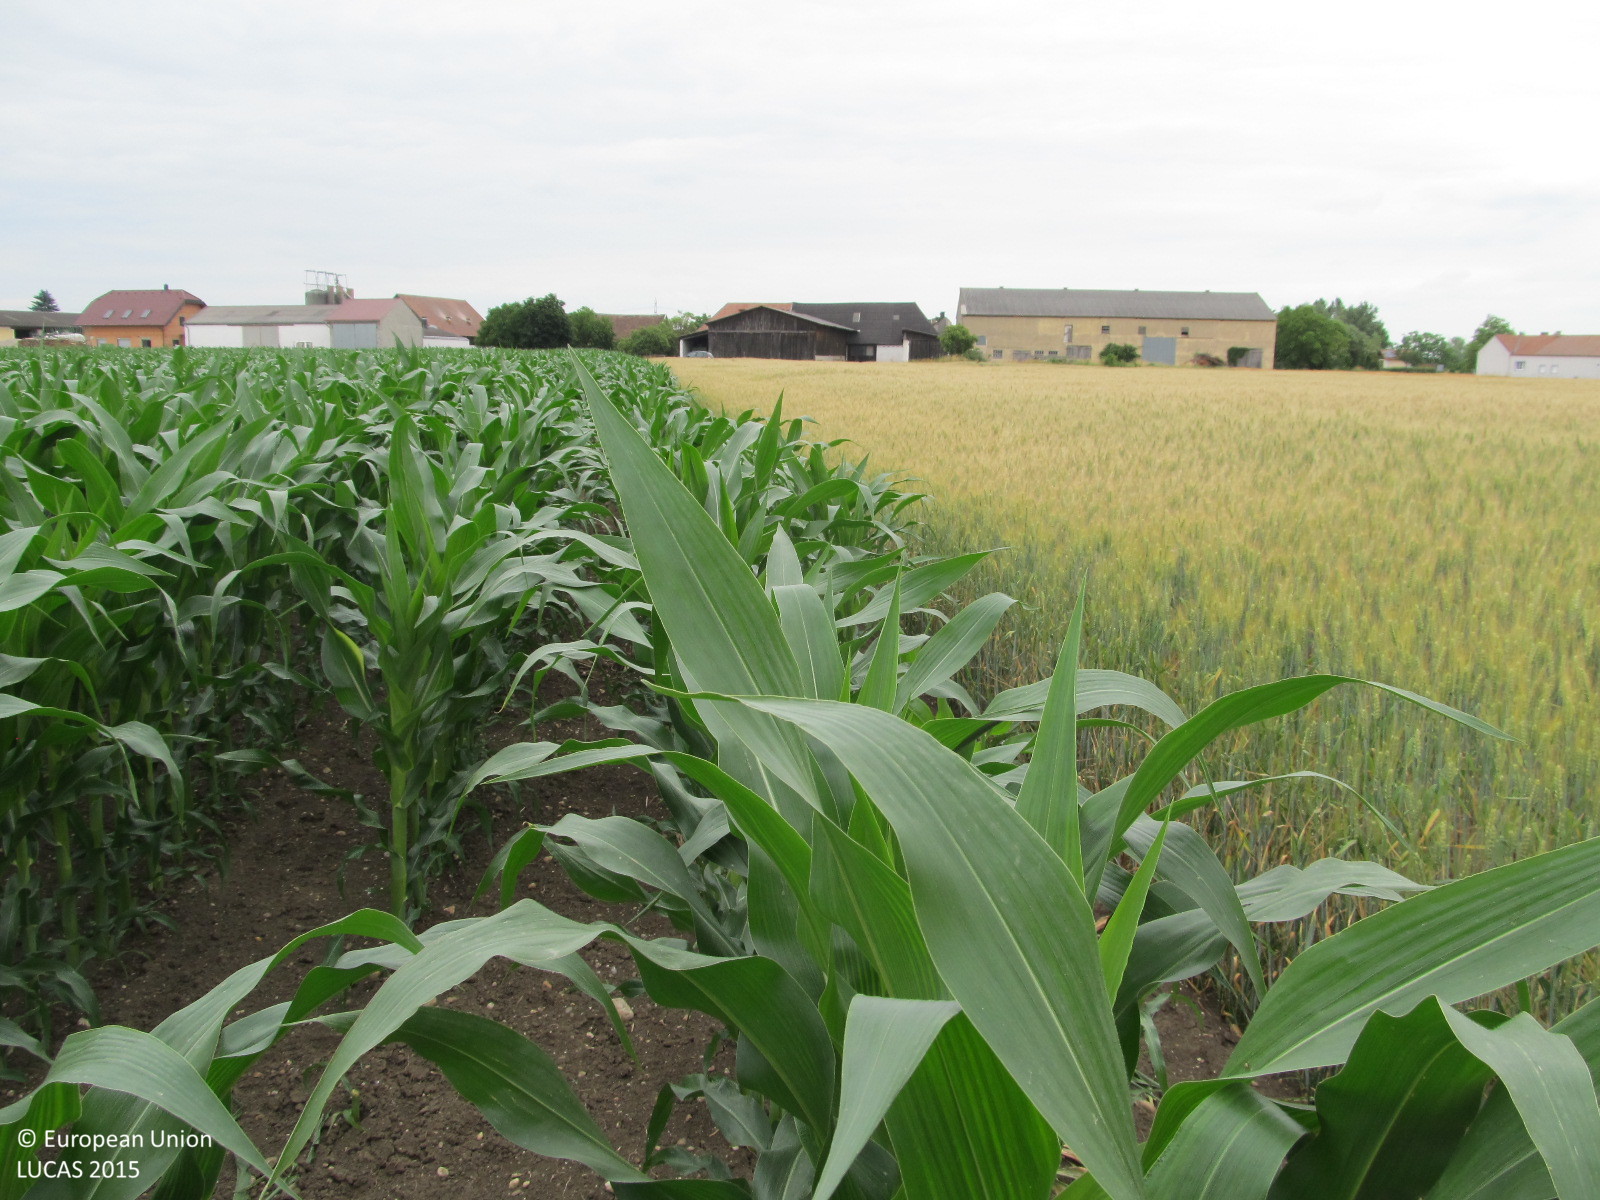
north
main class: Cropland
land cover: Maize
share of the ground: 50 - 75 %
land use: Agriculture (excluding fallow land and kitchen gardens)
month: June
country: AT
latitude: 48.3391
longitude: 15.8451
